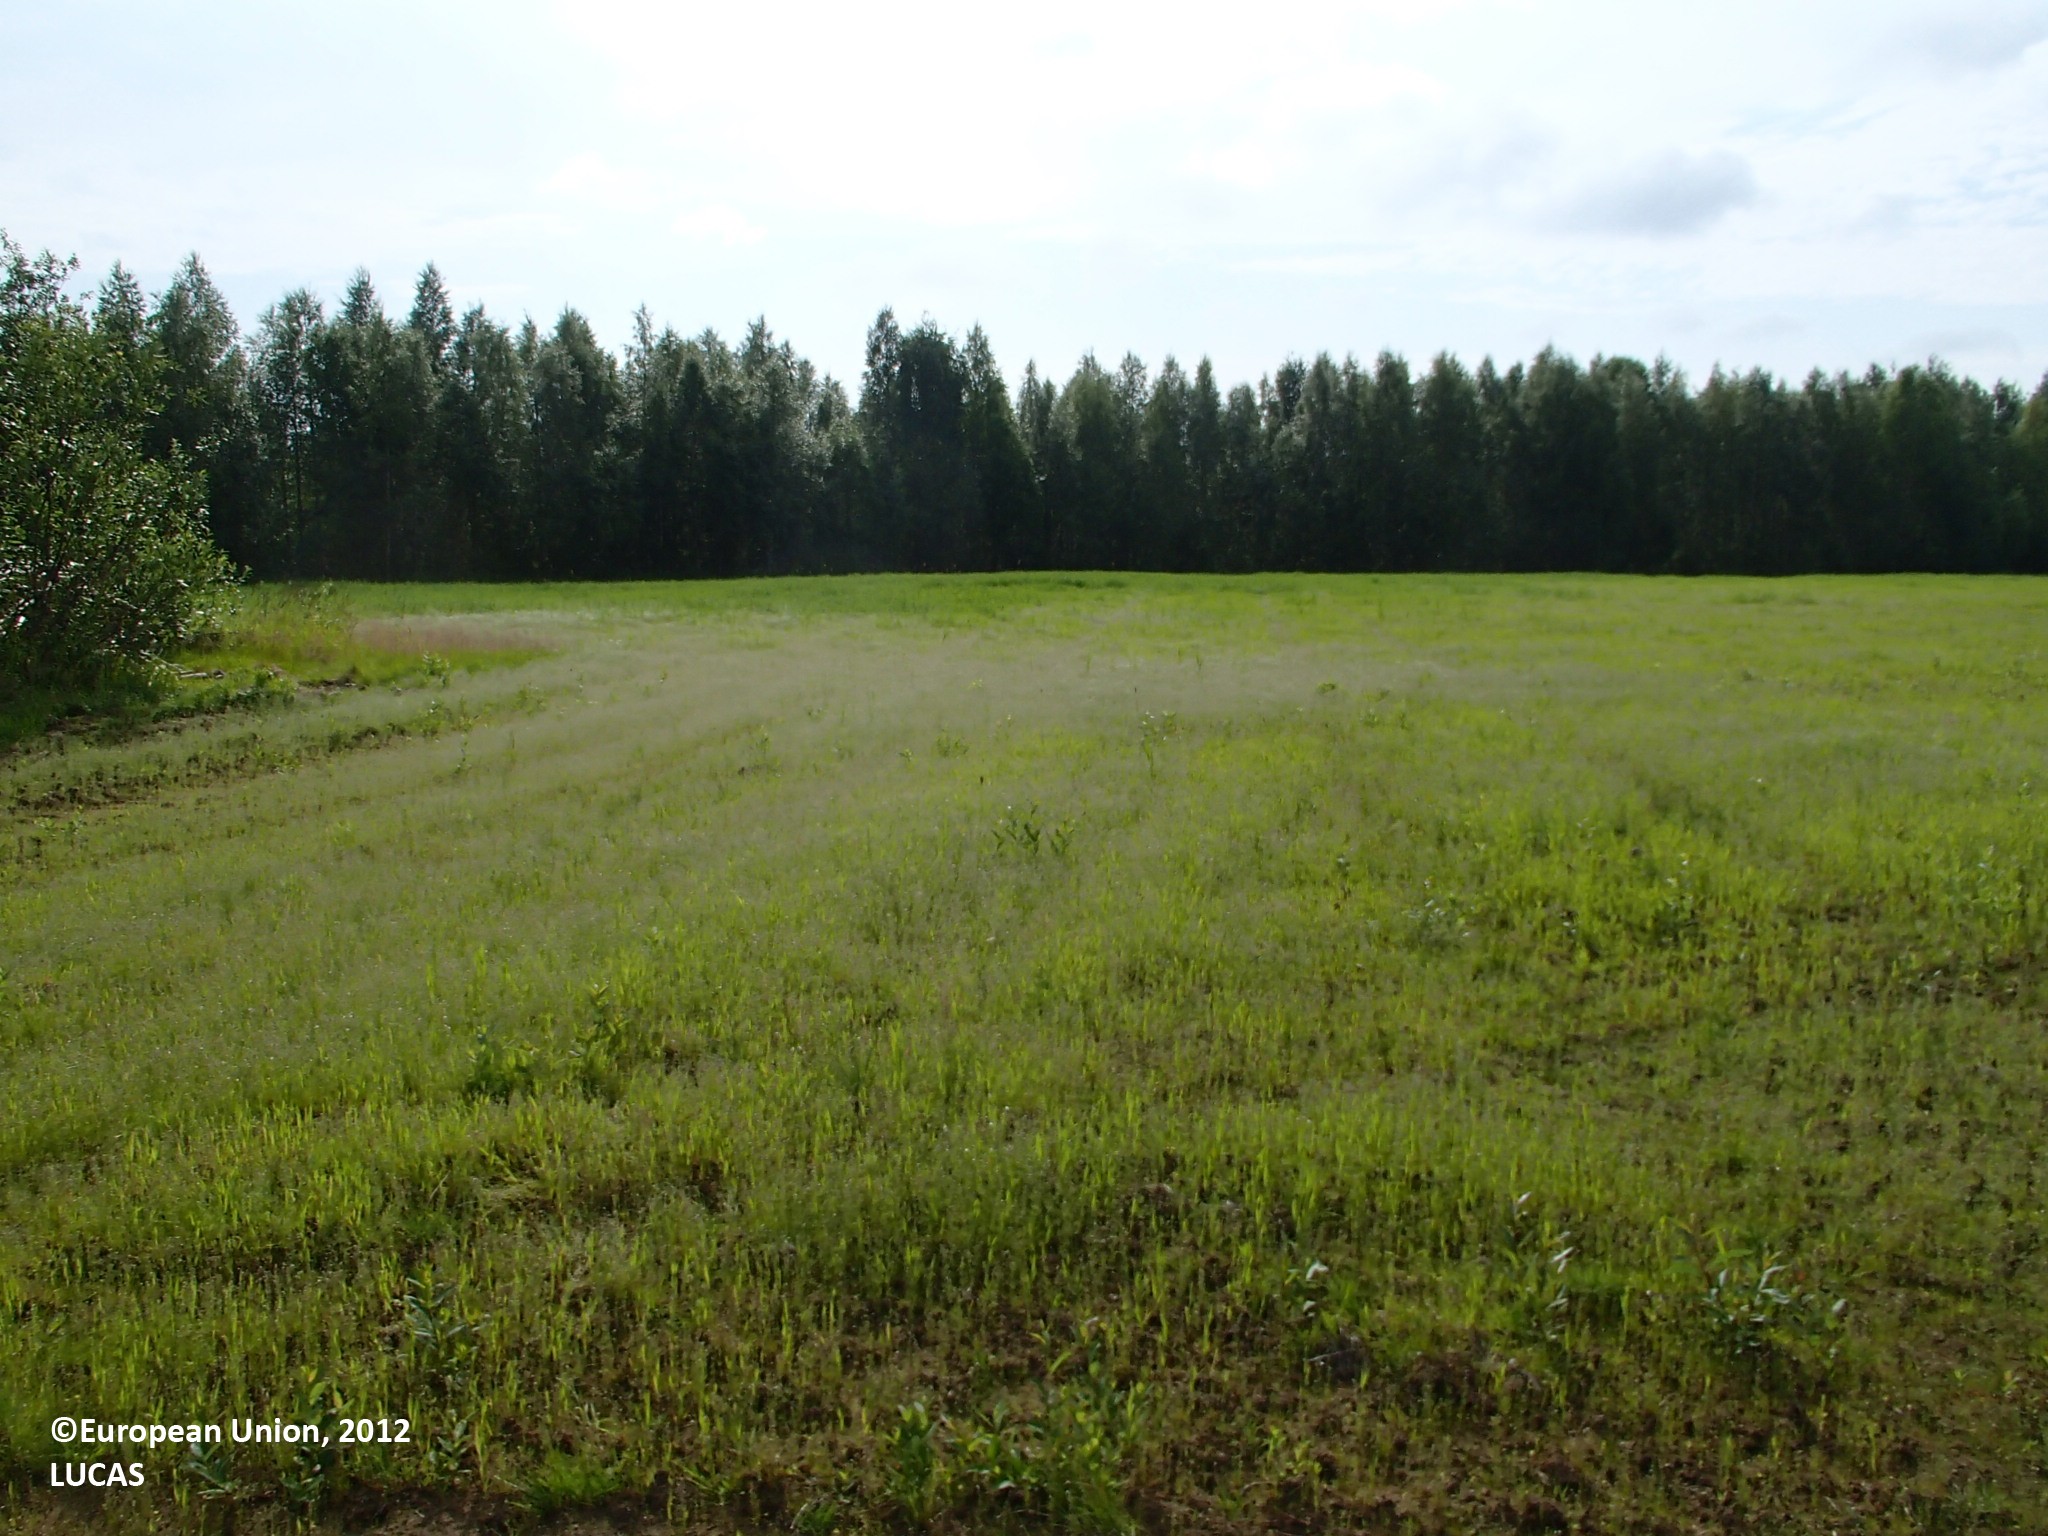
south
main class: Cropland
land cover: Temporary grasslands
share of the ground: 50 - 75 %
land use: Agriculture (excluding fallow land and kitchen gardens)
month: July
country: FI
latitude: 66.1829
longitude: 25.3104
